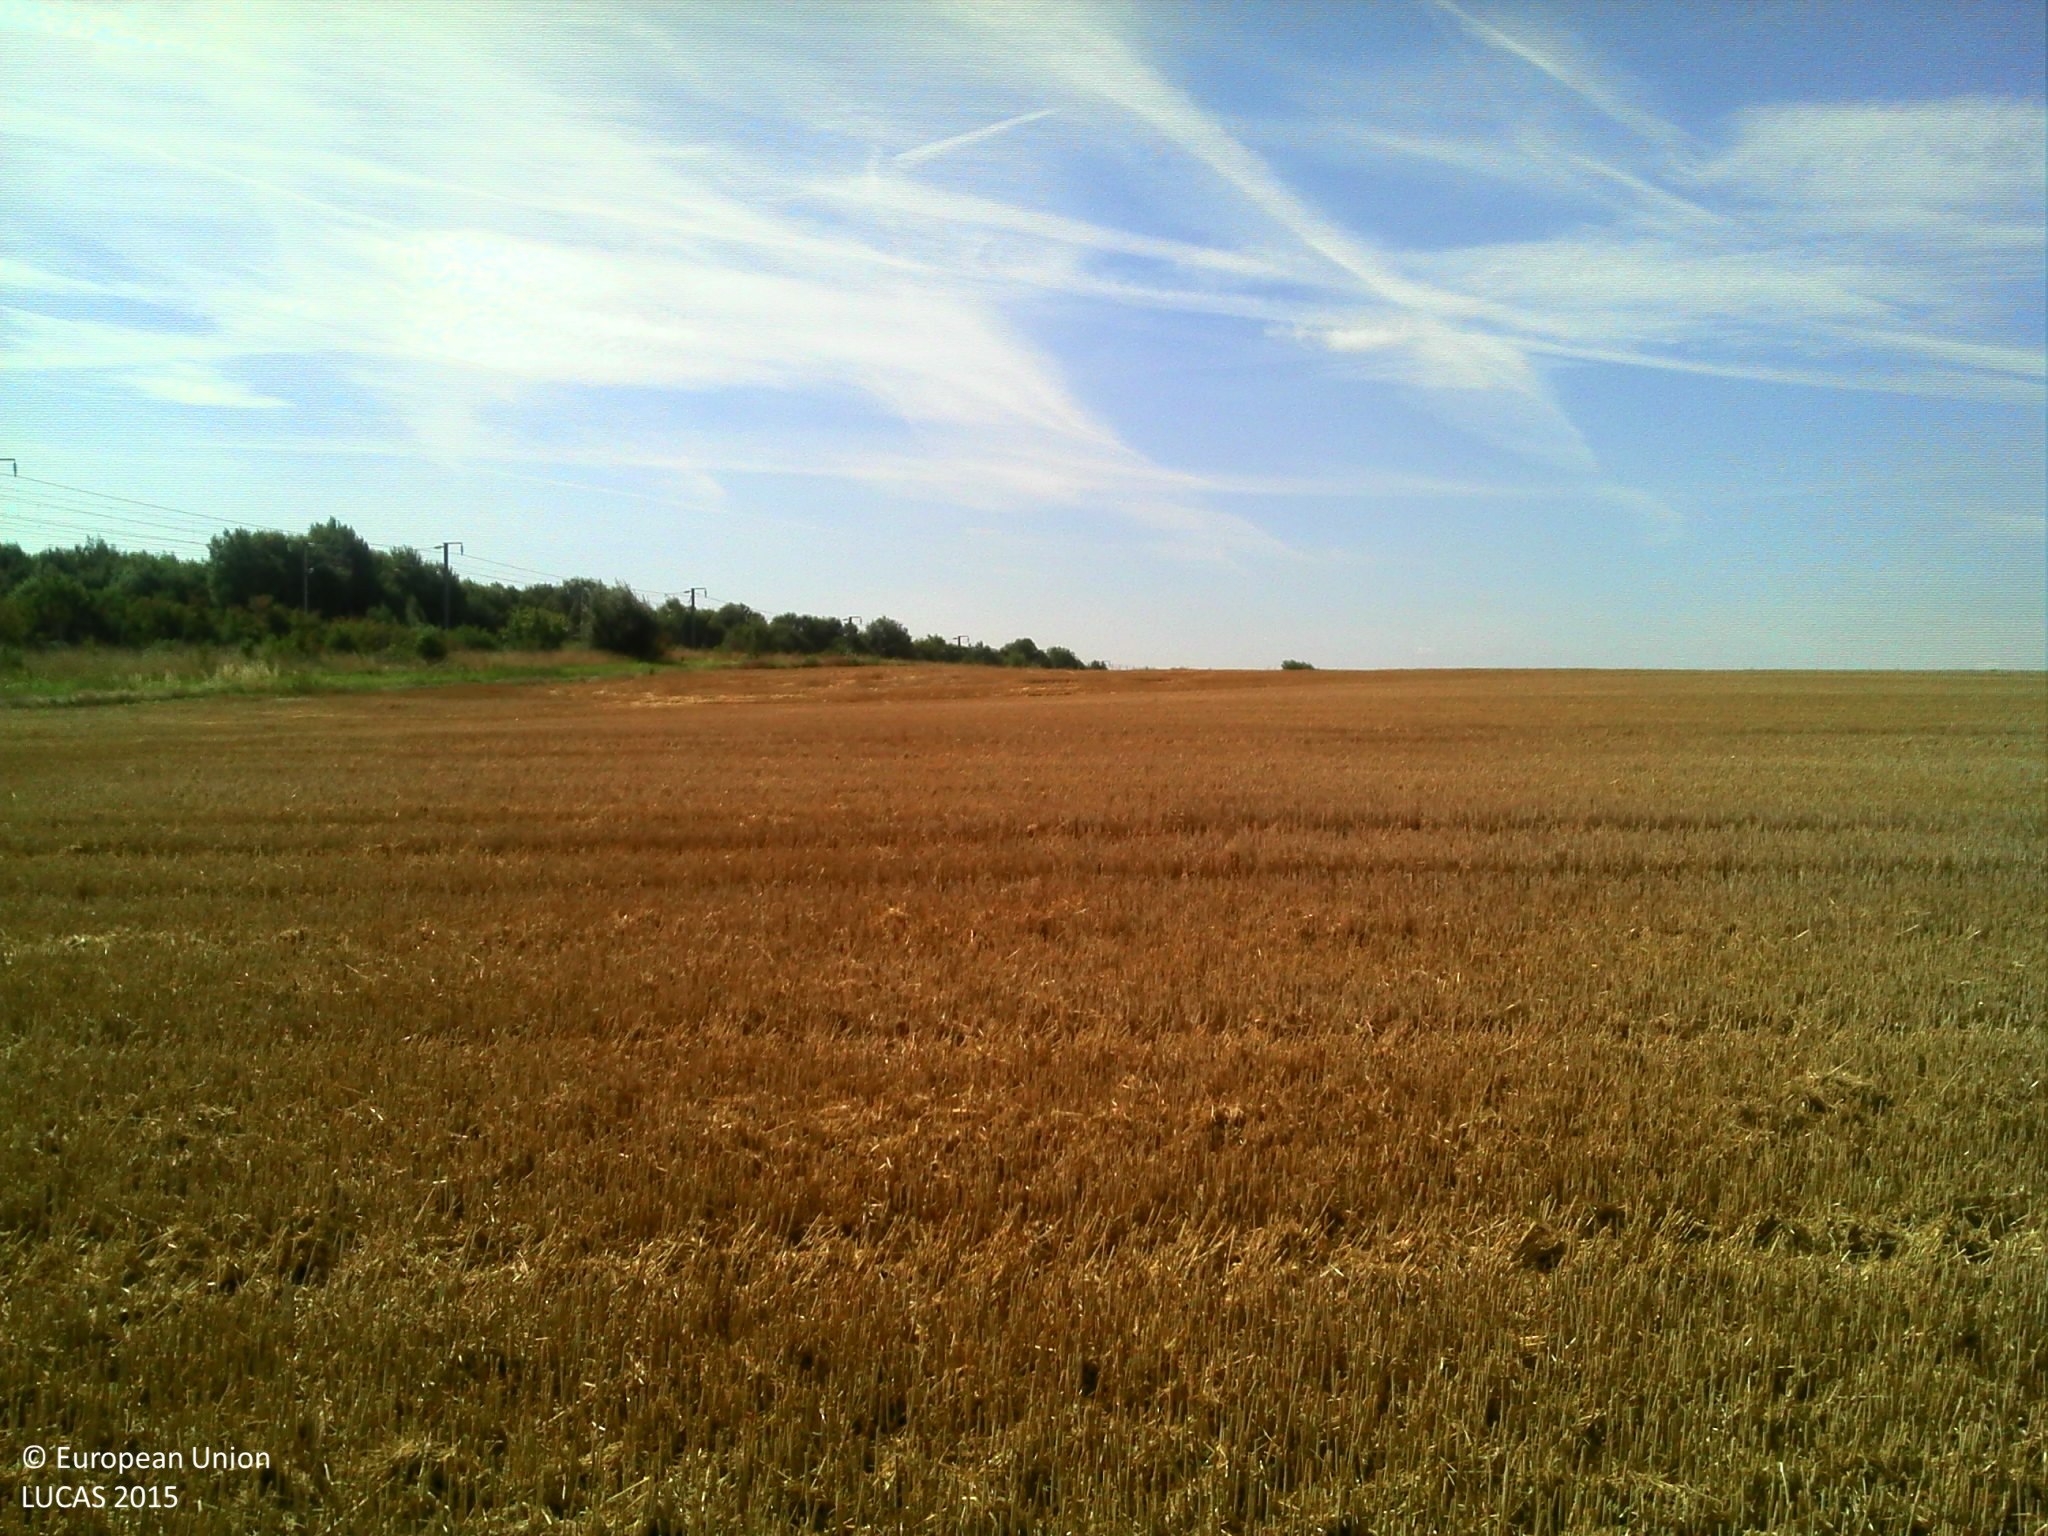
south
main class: Cropland
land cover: Common wheat
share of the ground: > 75 %
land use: Agriculture (excluding fallow land and kitchen gardens)
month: August
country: FR
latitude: 49.9053
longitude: 2.8467
